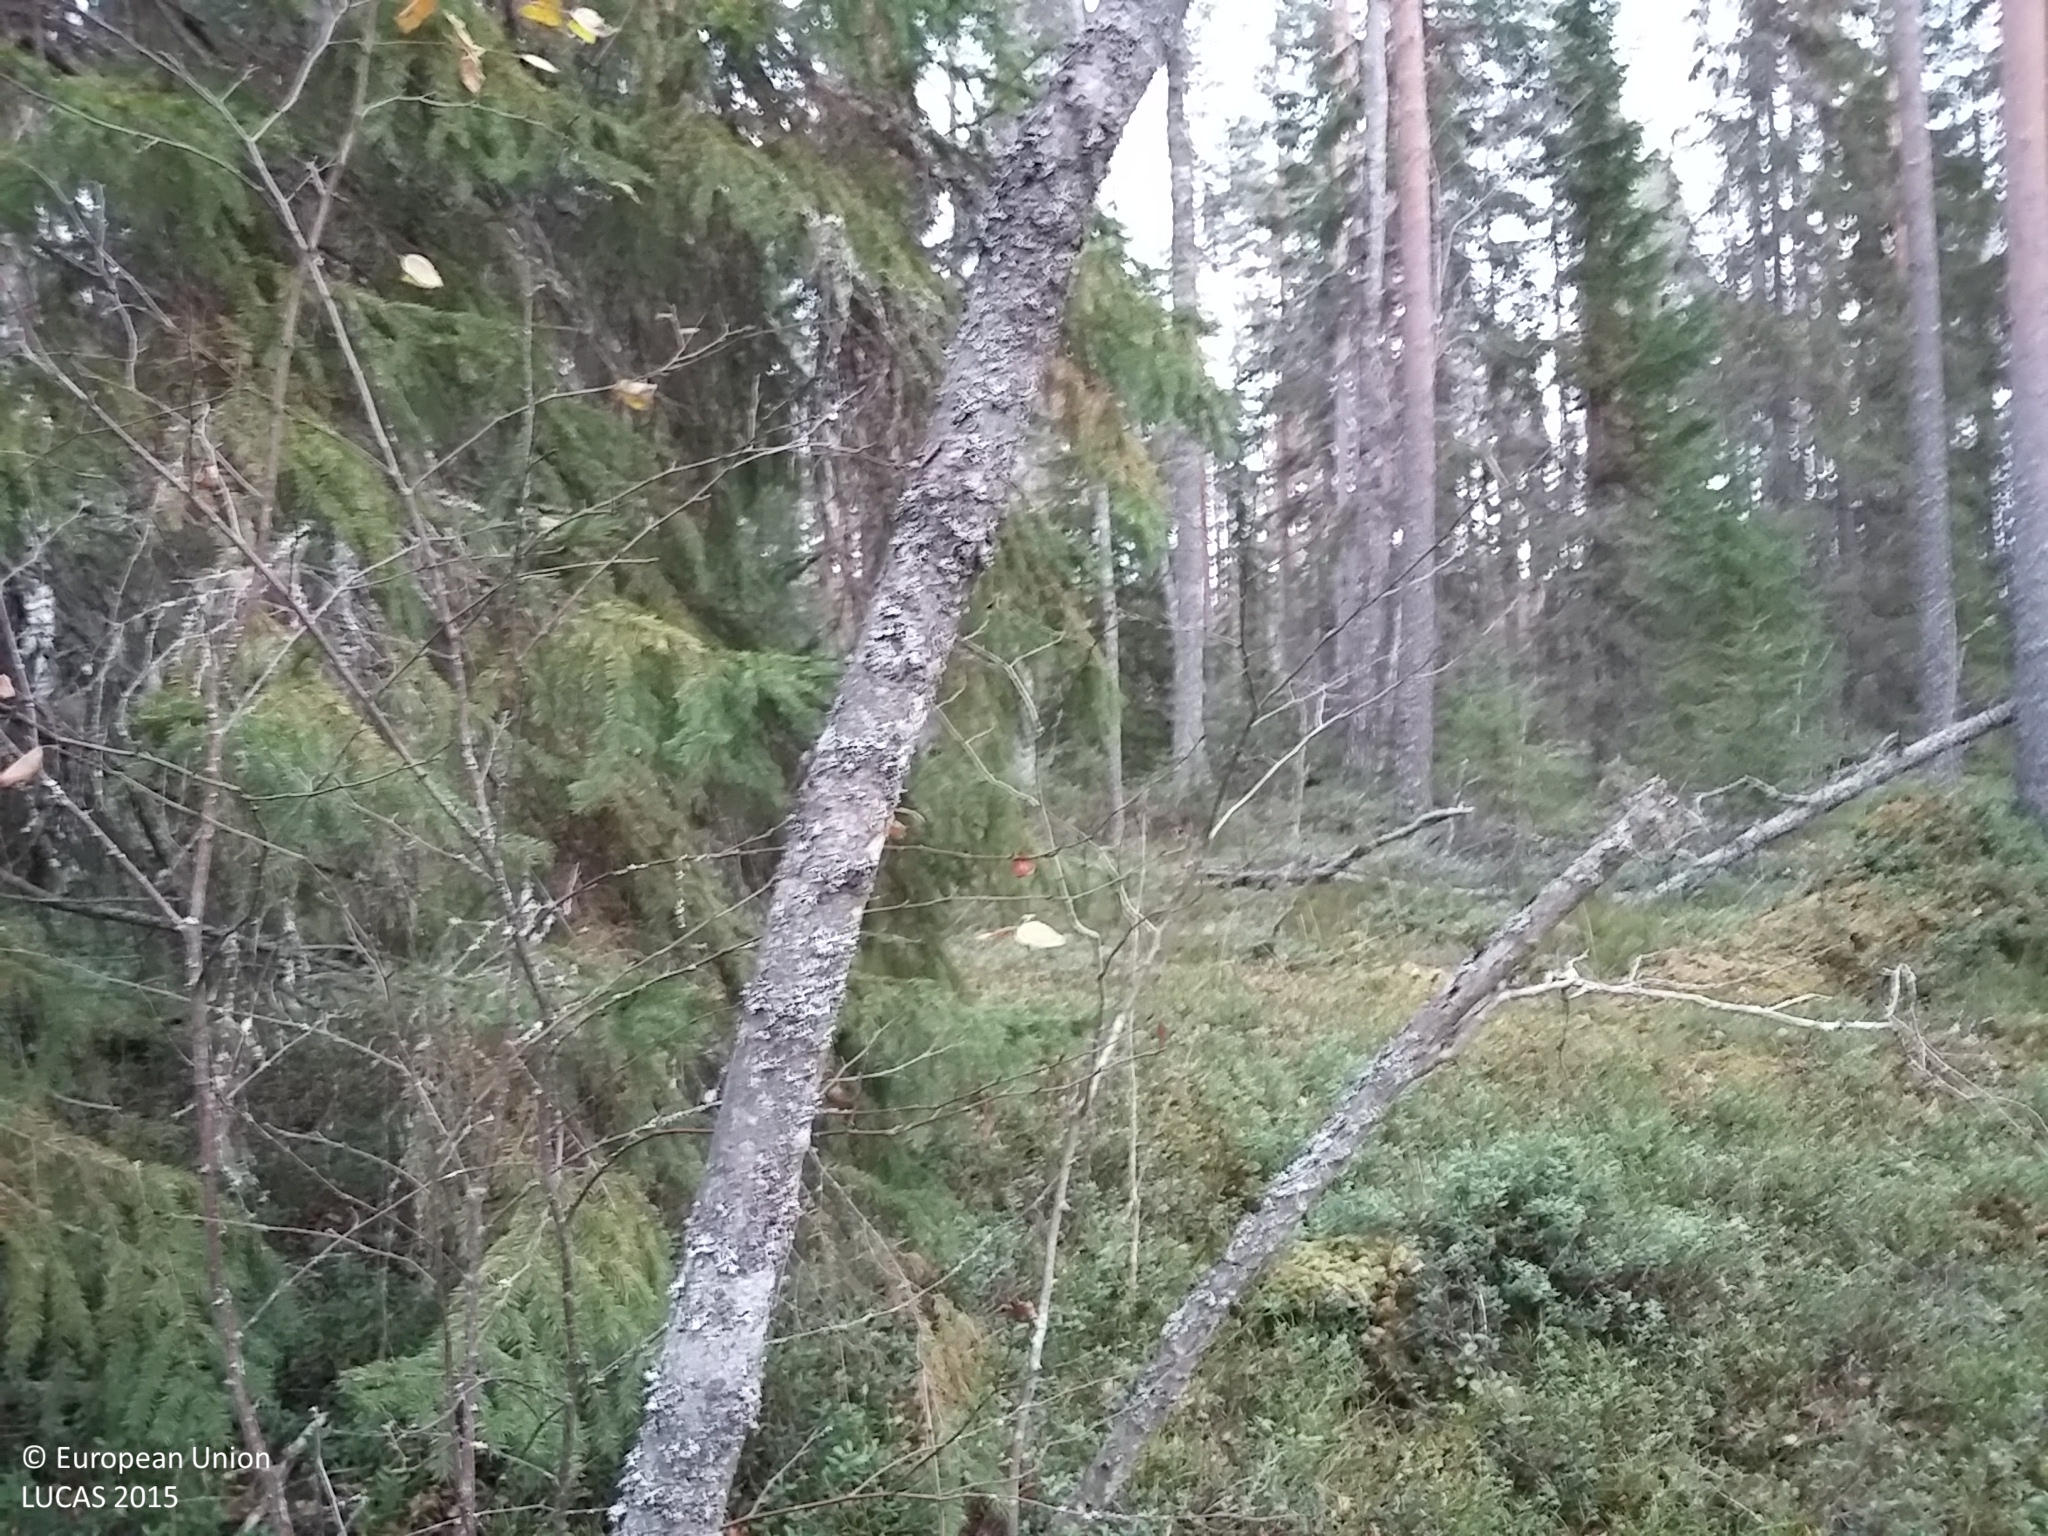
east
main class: Woodland
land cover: Spruce dominated mixed woodland
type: boreal forest
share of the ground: > 75 %
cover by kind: coniferous forest trees 45 %, broadleaved forest trees 35 %, shrubs 10 %, herbaceous plants 5 %, lichens and mosses 5 %
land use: Forestry
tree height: > 5 m
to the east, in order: Spruce dominated mixed woodland; Pine dominated mixed woodland; Pine dominated coniferous woodland; Tracks; Pine dominated coniferous woodland; Pine dominated mixed woodland
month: October
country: FI
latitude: 64.0510
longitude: 24.9749
